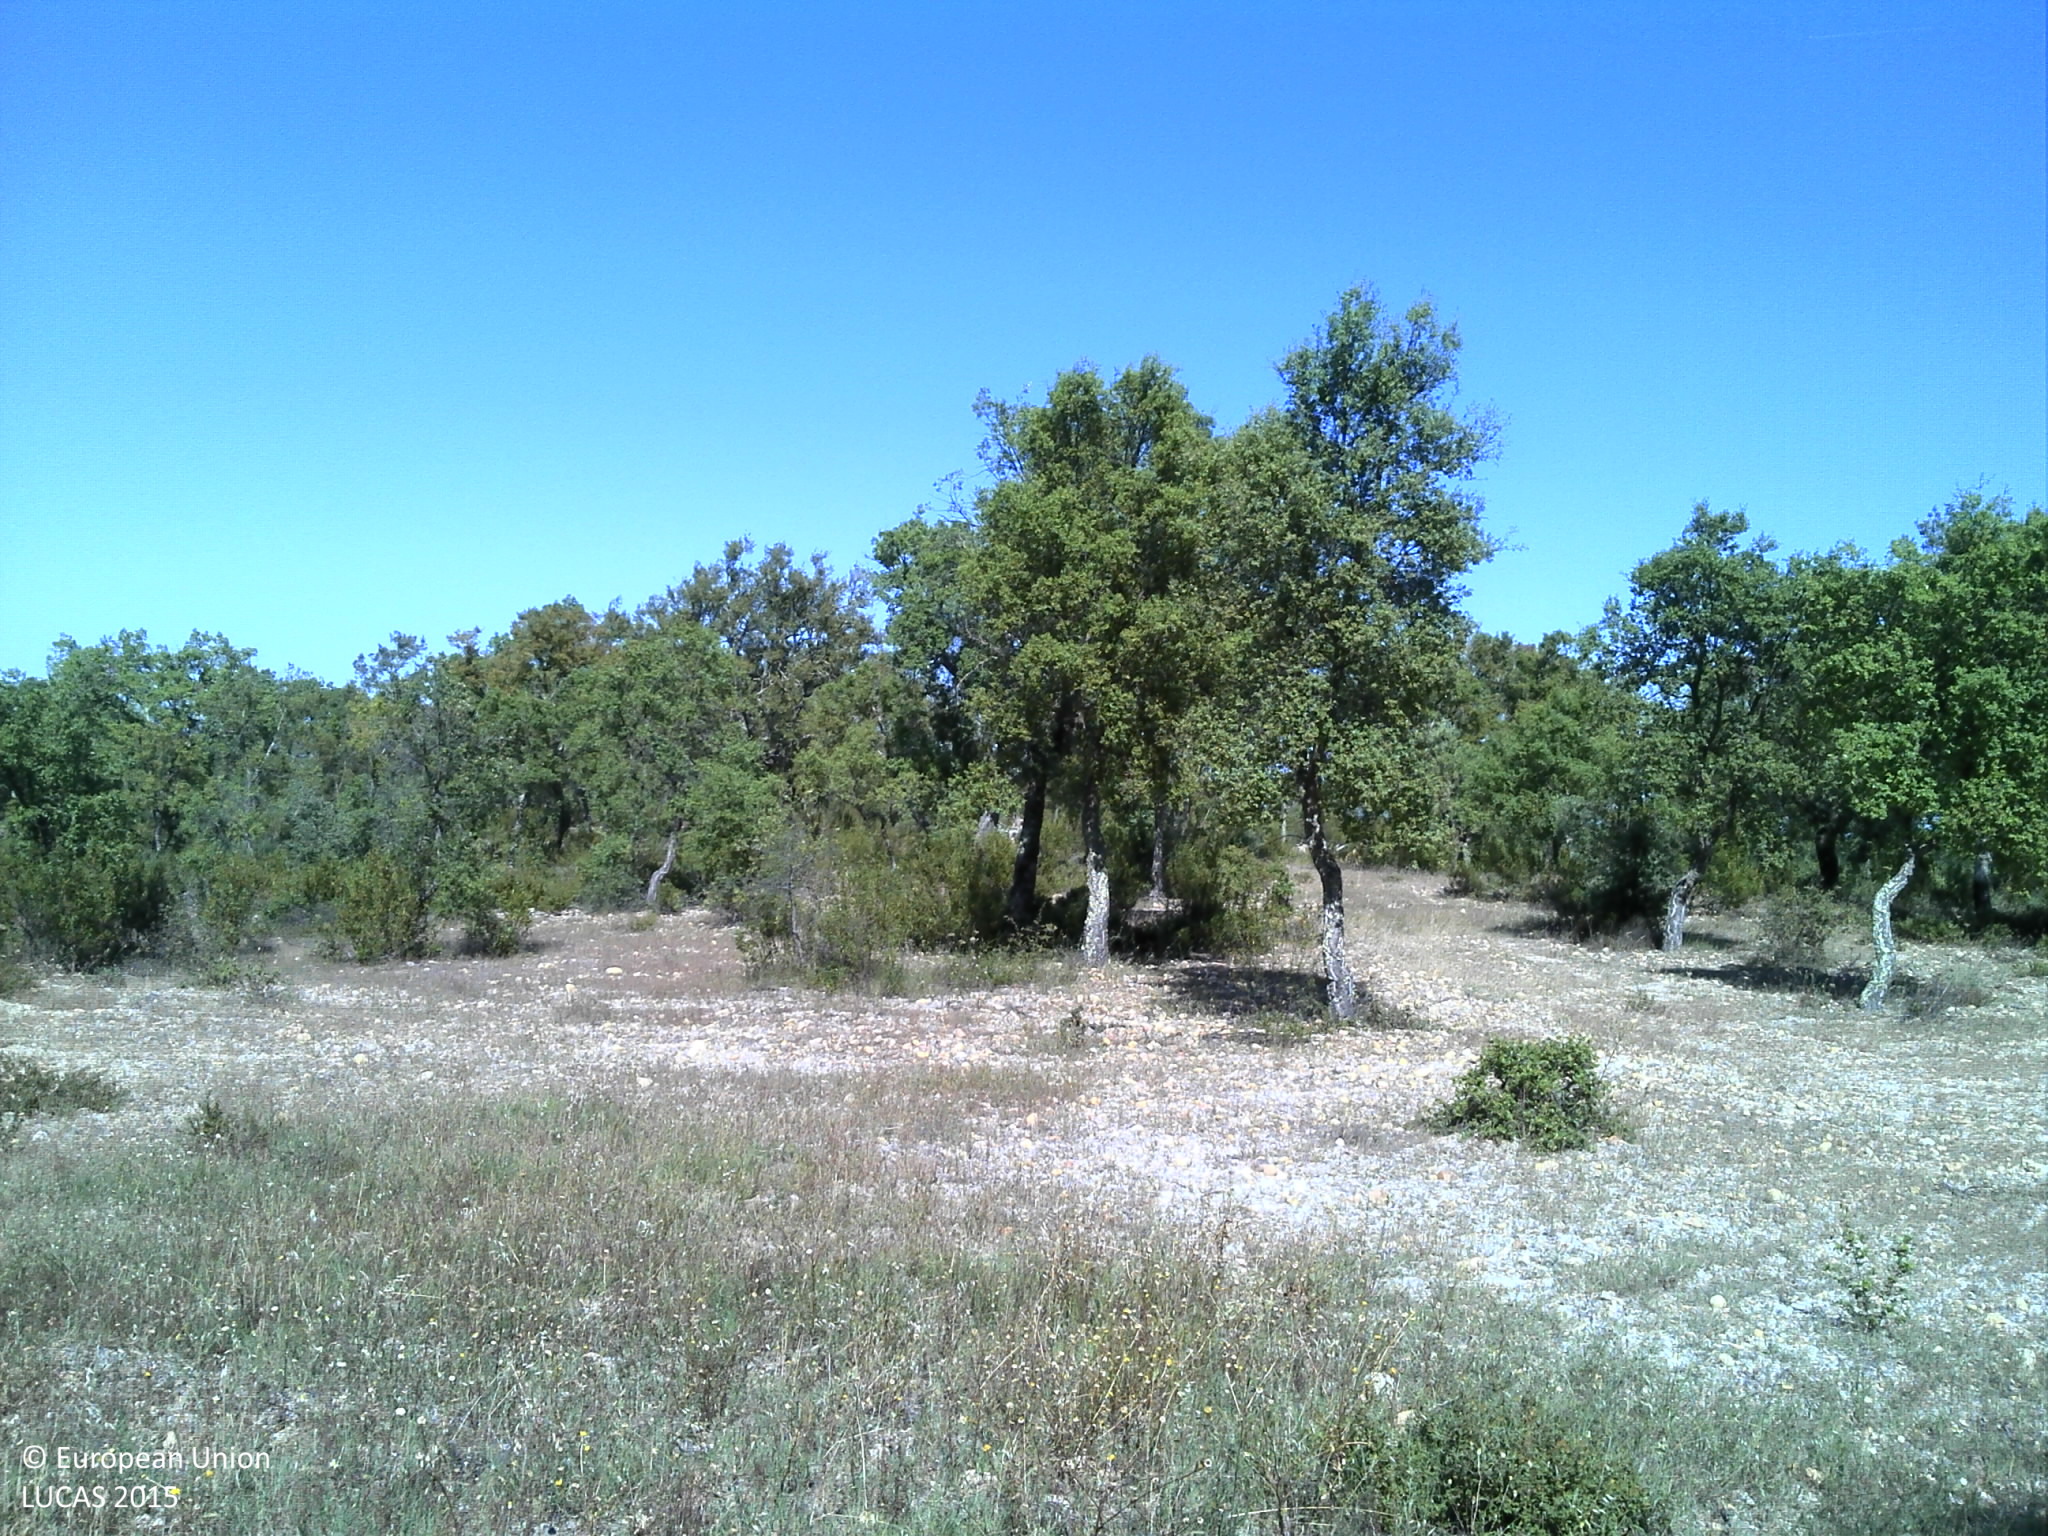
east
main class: Woodland
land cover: Broadleaved woodland
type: broadleaved evergreen forest
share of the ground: 10 - 25 %
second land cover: Grassland without tree/shrub cover
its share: 10 - 25 %
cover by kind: unconsolidated bare surface 55 %, herbaceous plants 25 %, broadleaved forest trees 15 %, shrubs 5 %
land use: Forestry
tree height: > 5 m
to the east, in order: Broadleaved woodland; Grassland without tree/shrub cover; Broadleaved woodland
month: May
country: PT
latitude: 39.3606
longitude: -7.9159
